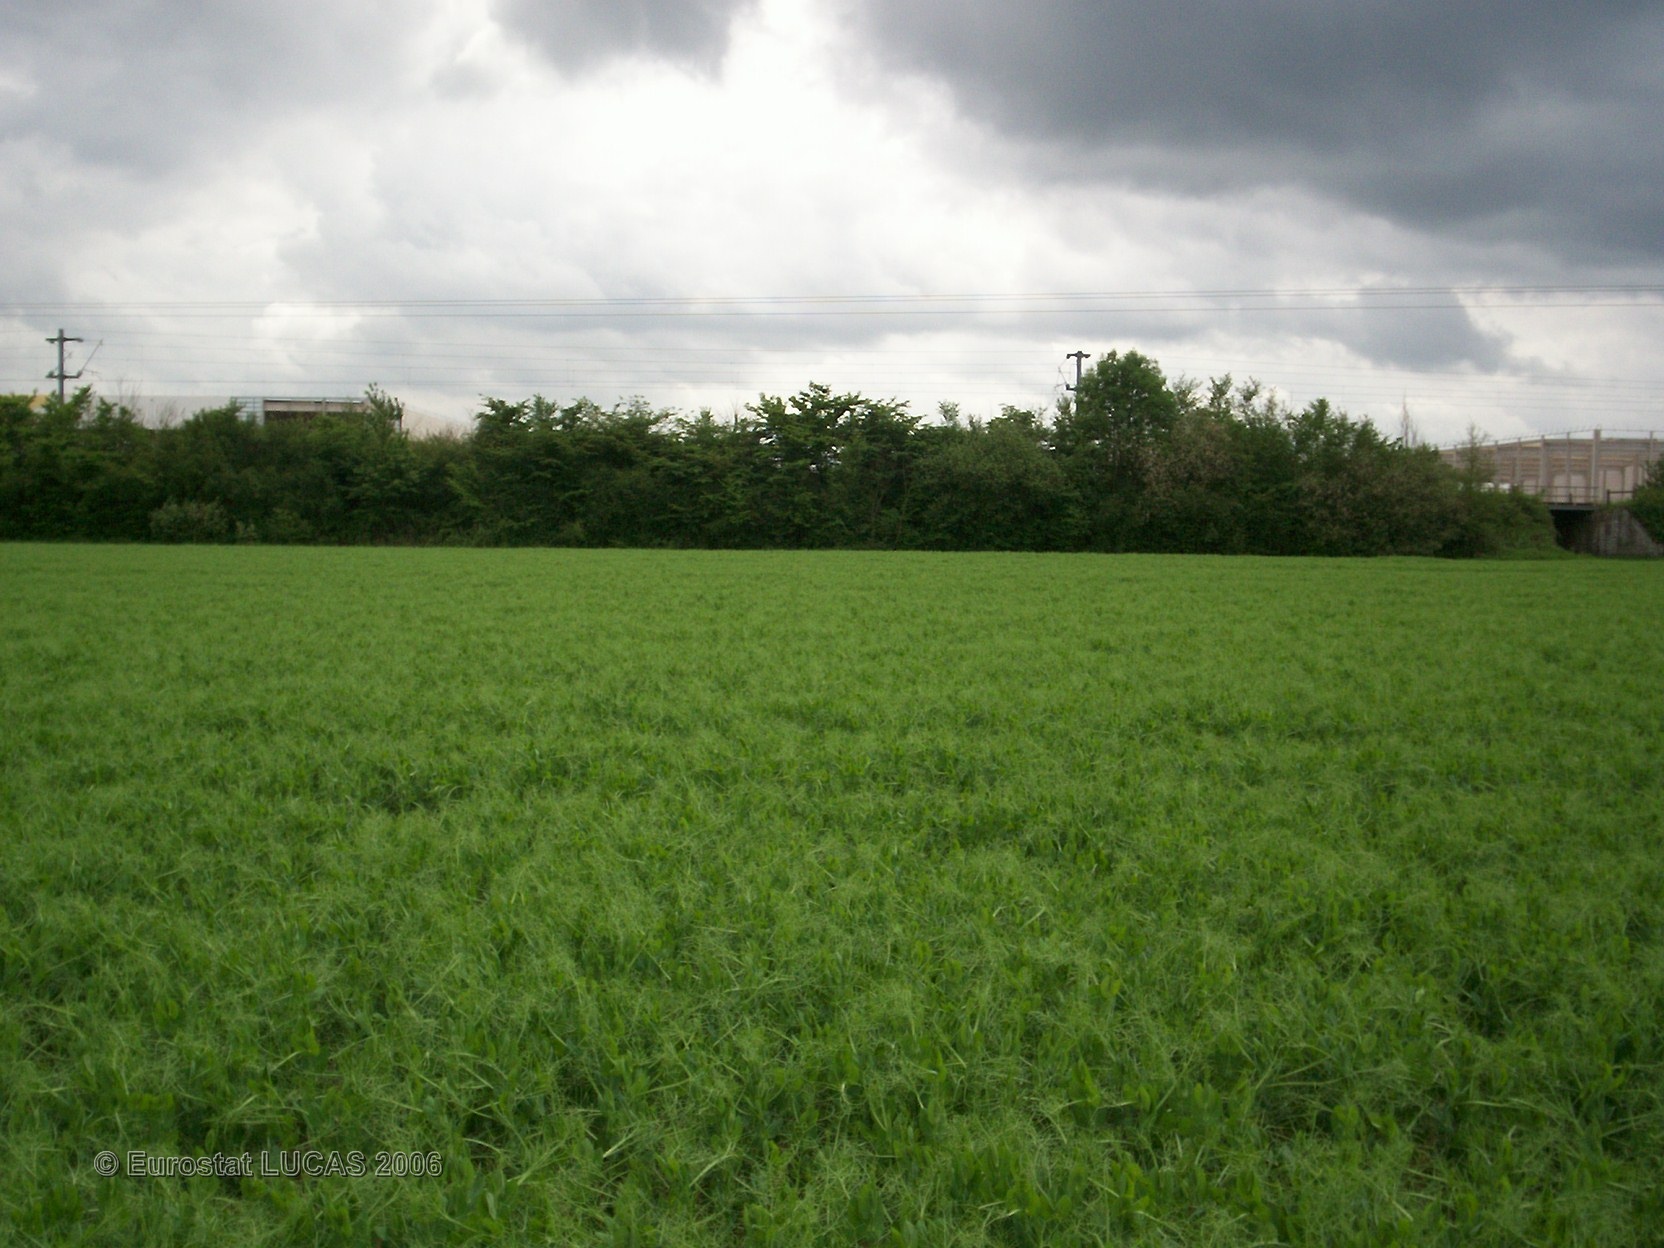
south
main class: Cropland
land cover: Dry pulses
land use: Agriculture (excluding fallow land and kitchen gardens)
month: May
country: FR
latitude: 48.7302
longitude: 2.8258
